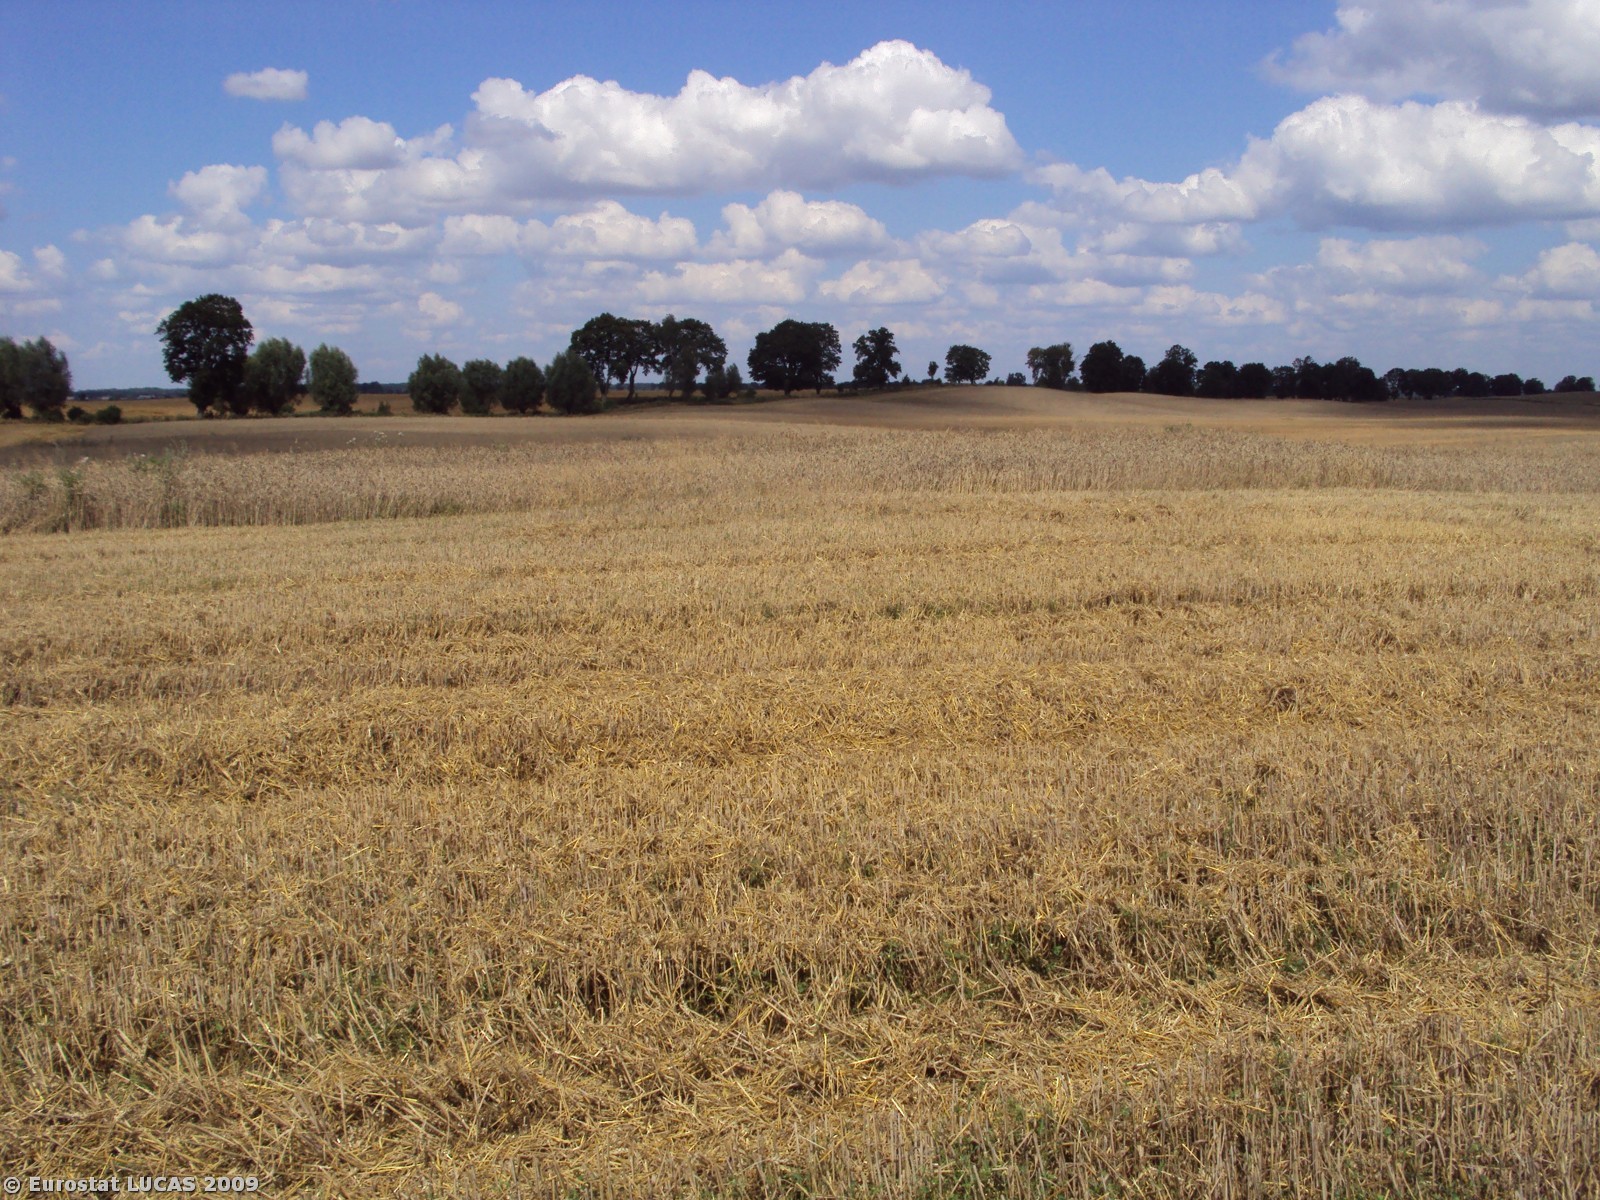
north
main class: Cropland
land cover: Common wheat
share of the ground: < 10 %
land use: Agriculture (excluding fallow land and kitchen gardens)
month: August
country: PL
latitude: 53.2146
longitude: 16.4010
